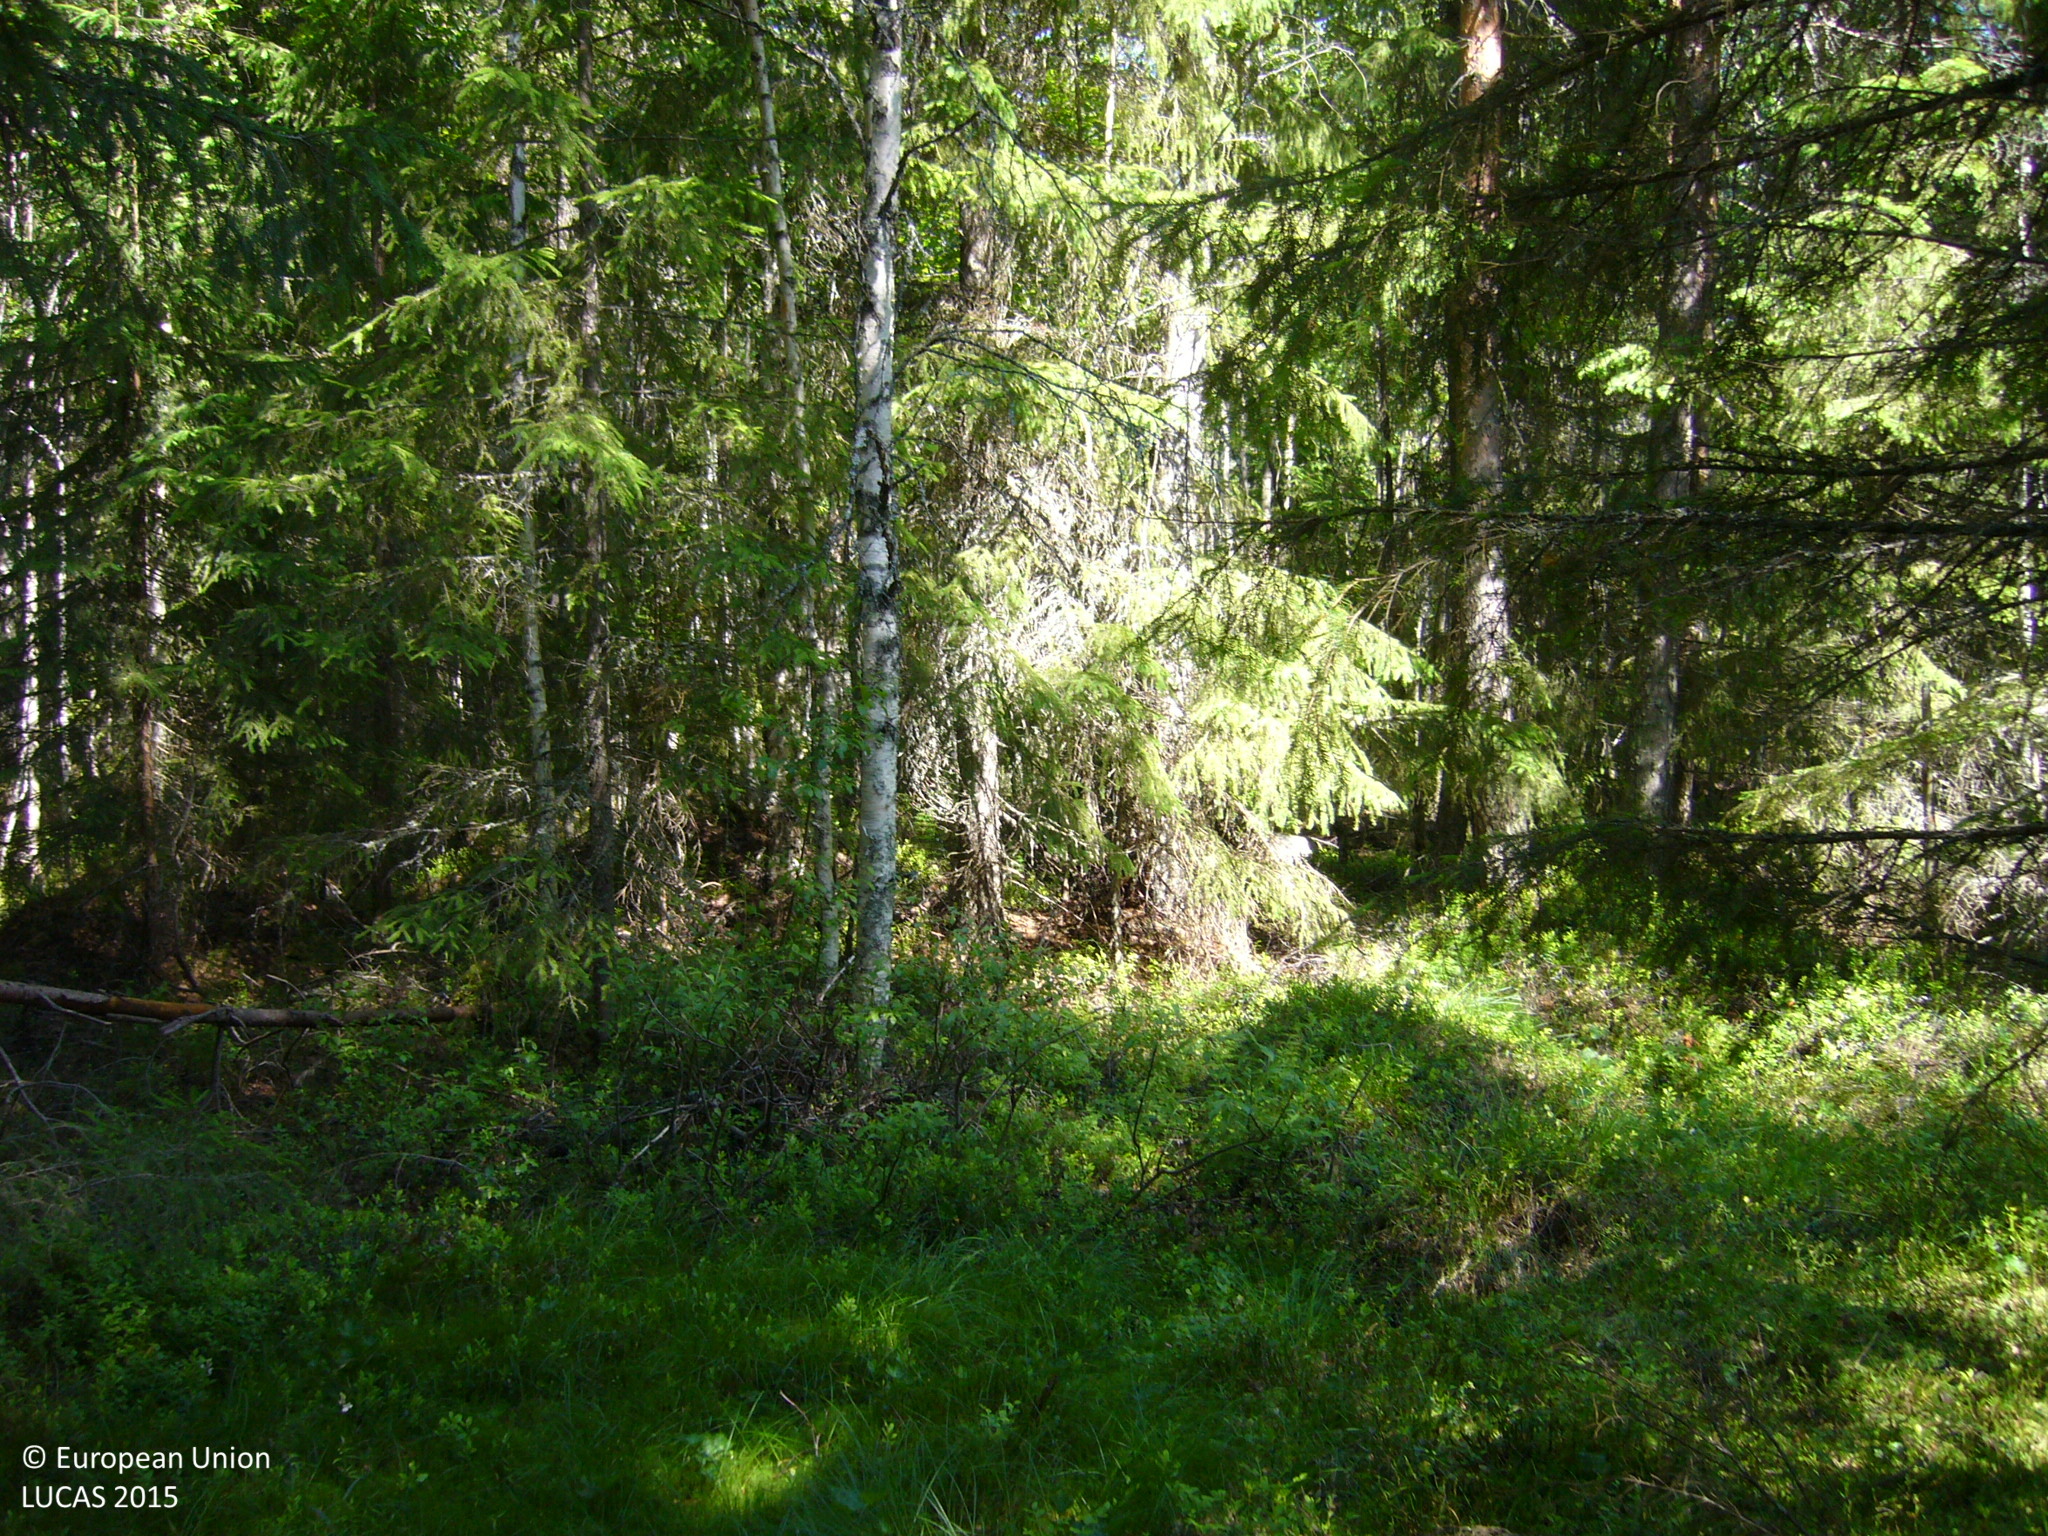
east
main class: Woodland
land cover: Spruce dominated mixed woodland
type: boreal forest
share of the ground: > 75 %
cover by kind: coniferous forest trees 60 %, broadleaved forest trees 25 %, shrubs 15 %
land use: Forestry
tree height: > 5 m
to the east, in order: Spruce dominated mixed woodland; Ditches and canals; Spruce dominated mixed woodland; Pine dominated mixed woodland; Ditches and canals; Pine dominated mixed woodland; Spruce dominated mixed woodland; Pine dominated coniferous woodland; Spruce dominated coniferous woodland; Pine dominated coniferous woodland
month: July
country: FI
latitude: 63.3732
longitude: 26.0147
